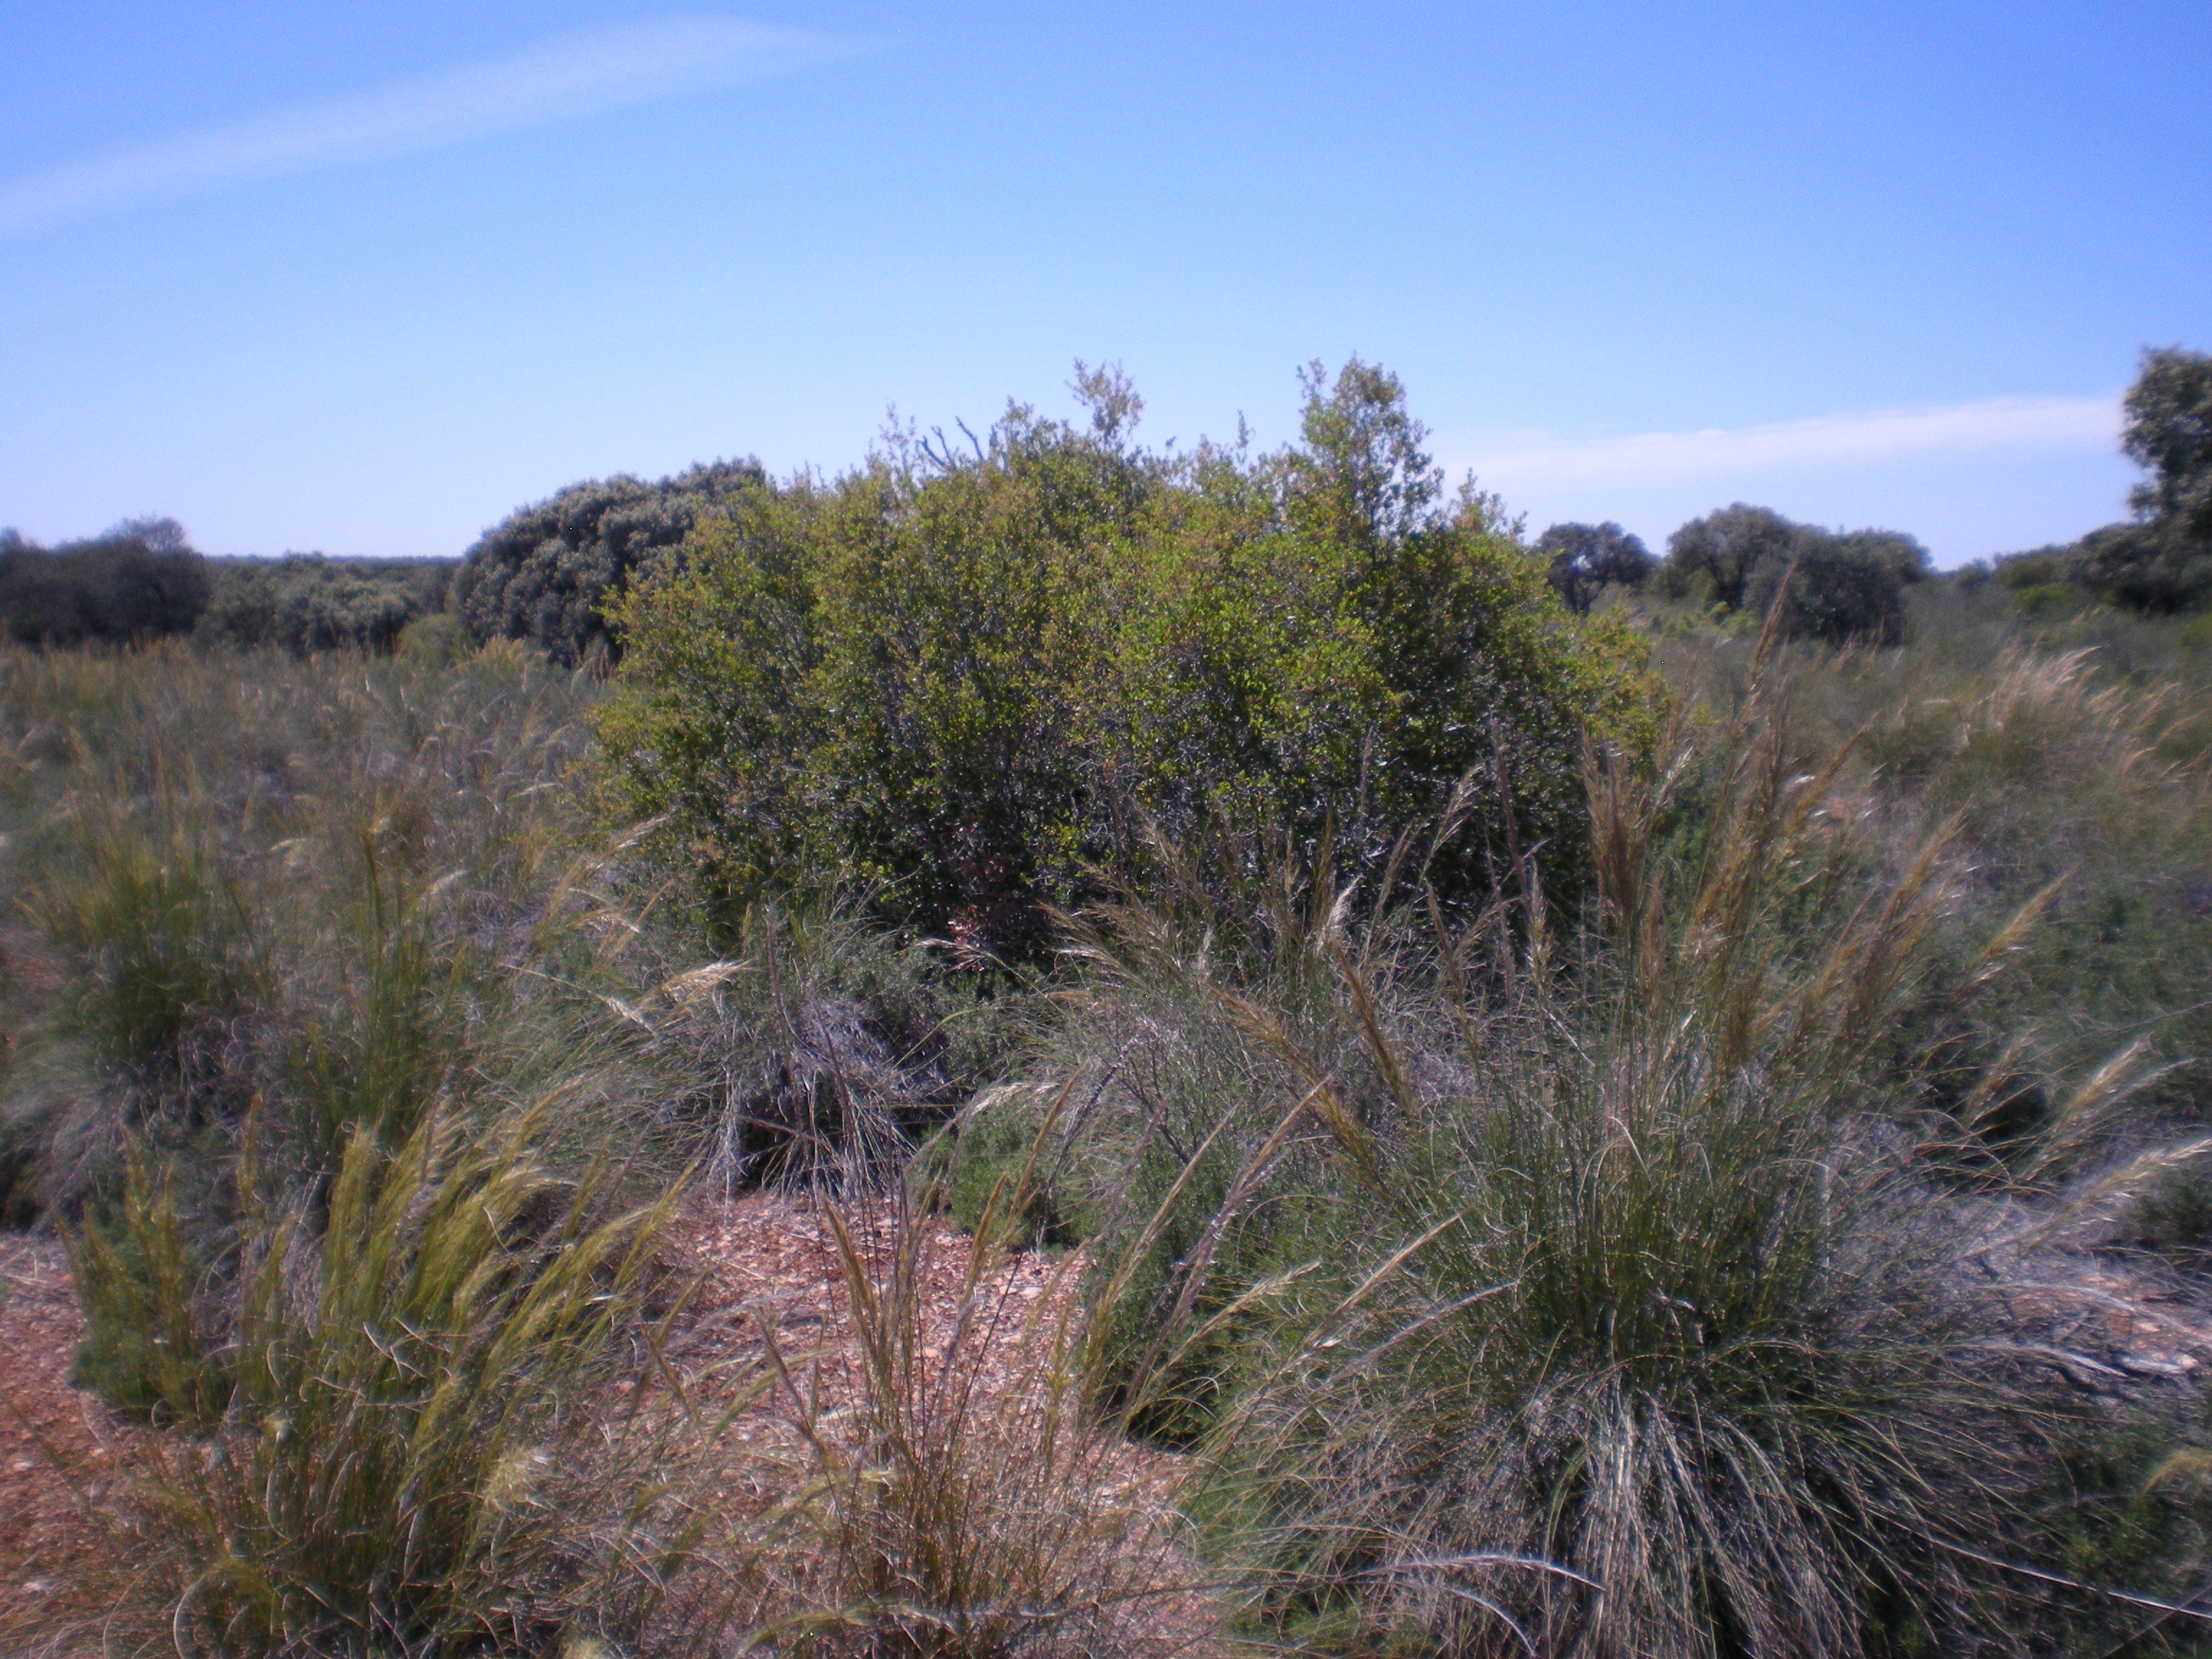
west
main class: Woodland
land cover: Broadleaved woodland
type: broadleaved evergreen forest
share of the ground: 50 - 75 %
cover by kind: shrubs 50 %, herbaceous plants 20 %, unconsolidated bare surface 20 %, broadleaved forest trees 10 %
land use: Semi-natural and natural areas not in use
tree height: < 5 m
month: May
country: ES
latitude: 39.0189
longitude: -3.0975
